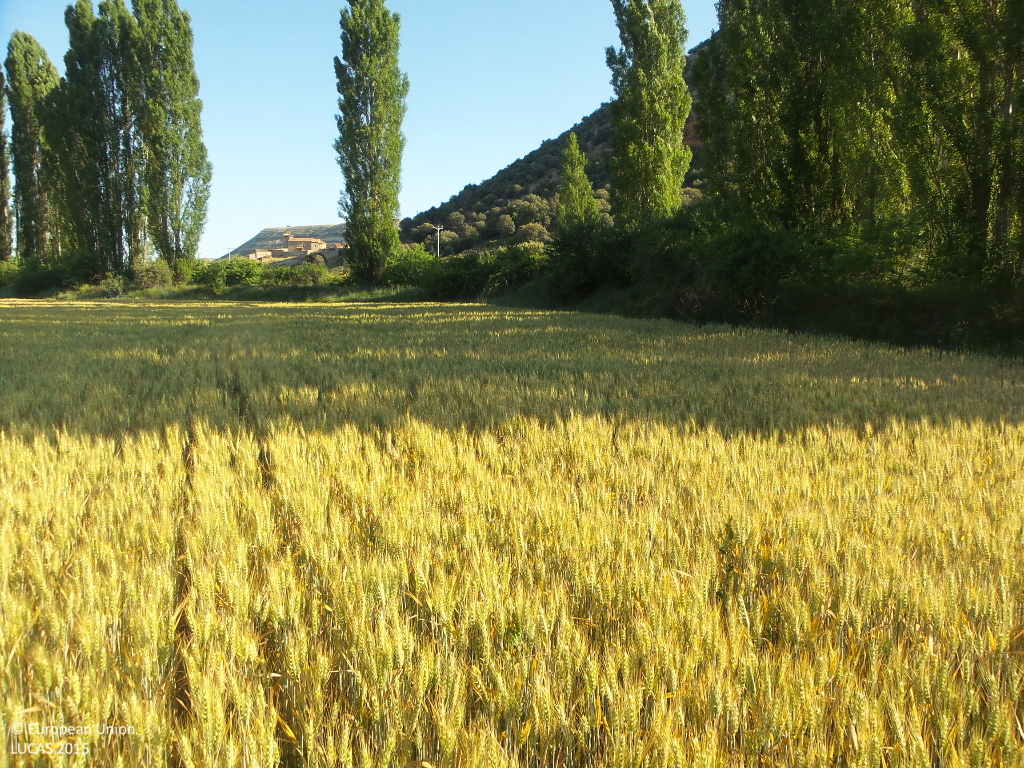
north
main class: Cropland
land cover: Common wheat
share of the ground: > 75 %
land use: Agriculture (excluding fallow land and kitchen gardens)
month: June
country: ES
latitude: 41.3733
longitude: -2.7222
